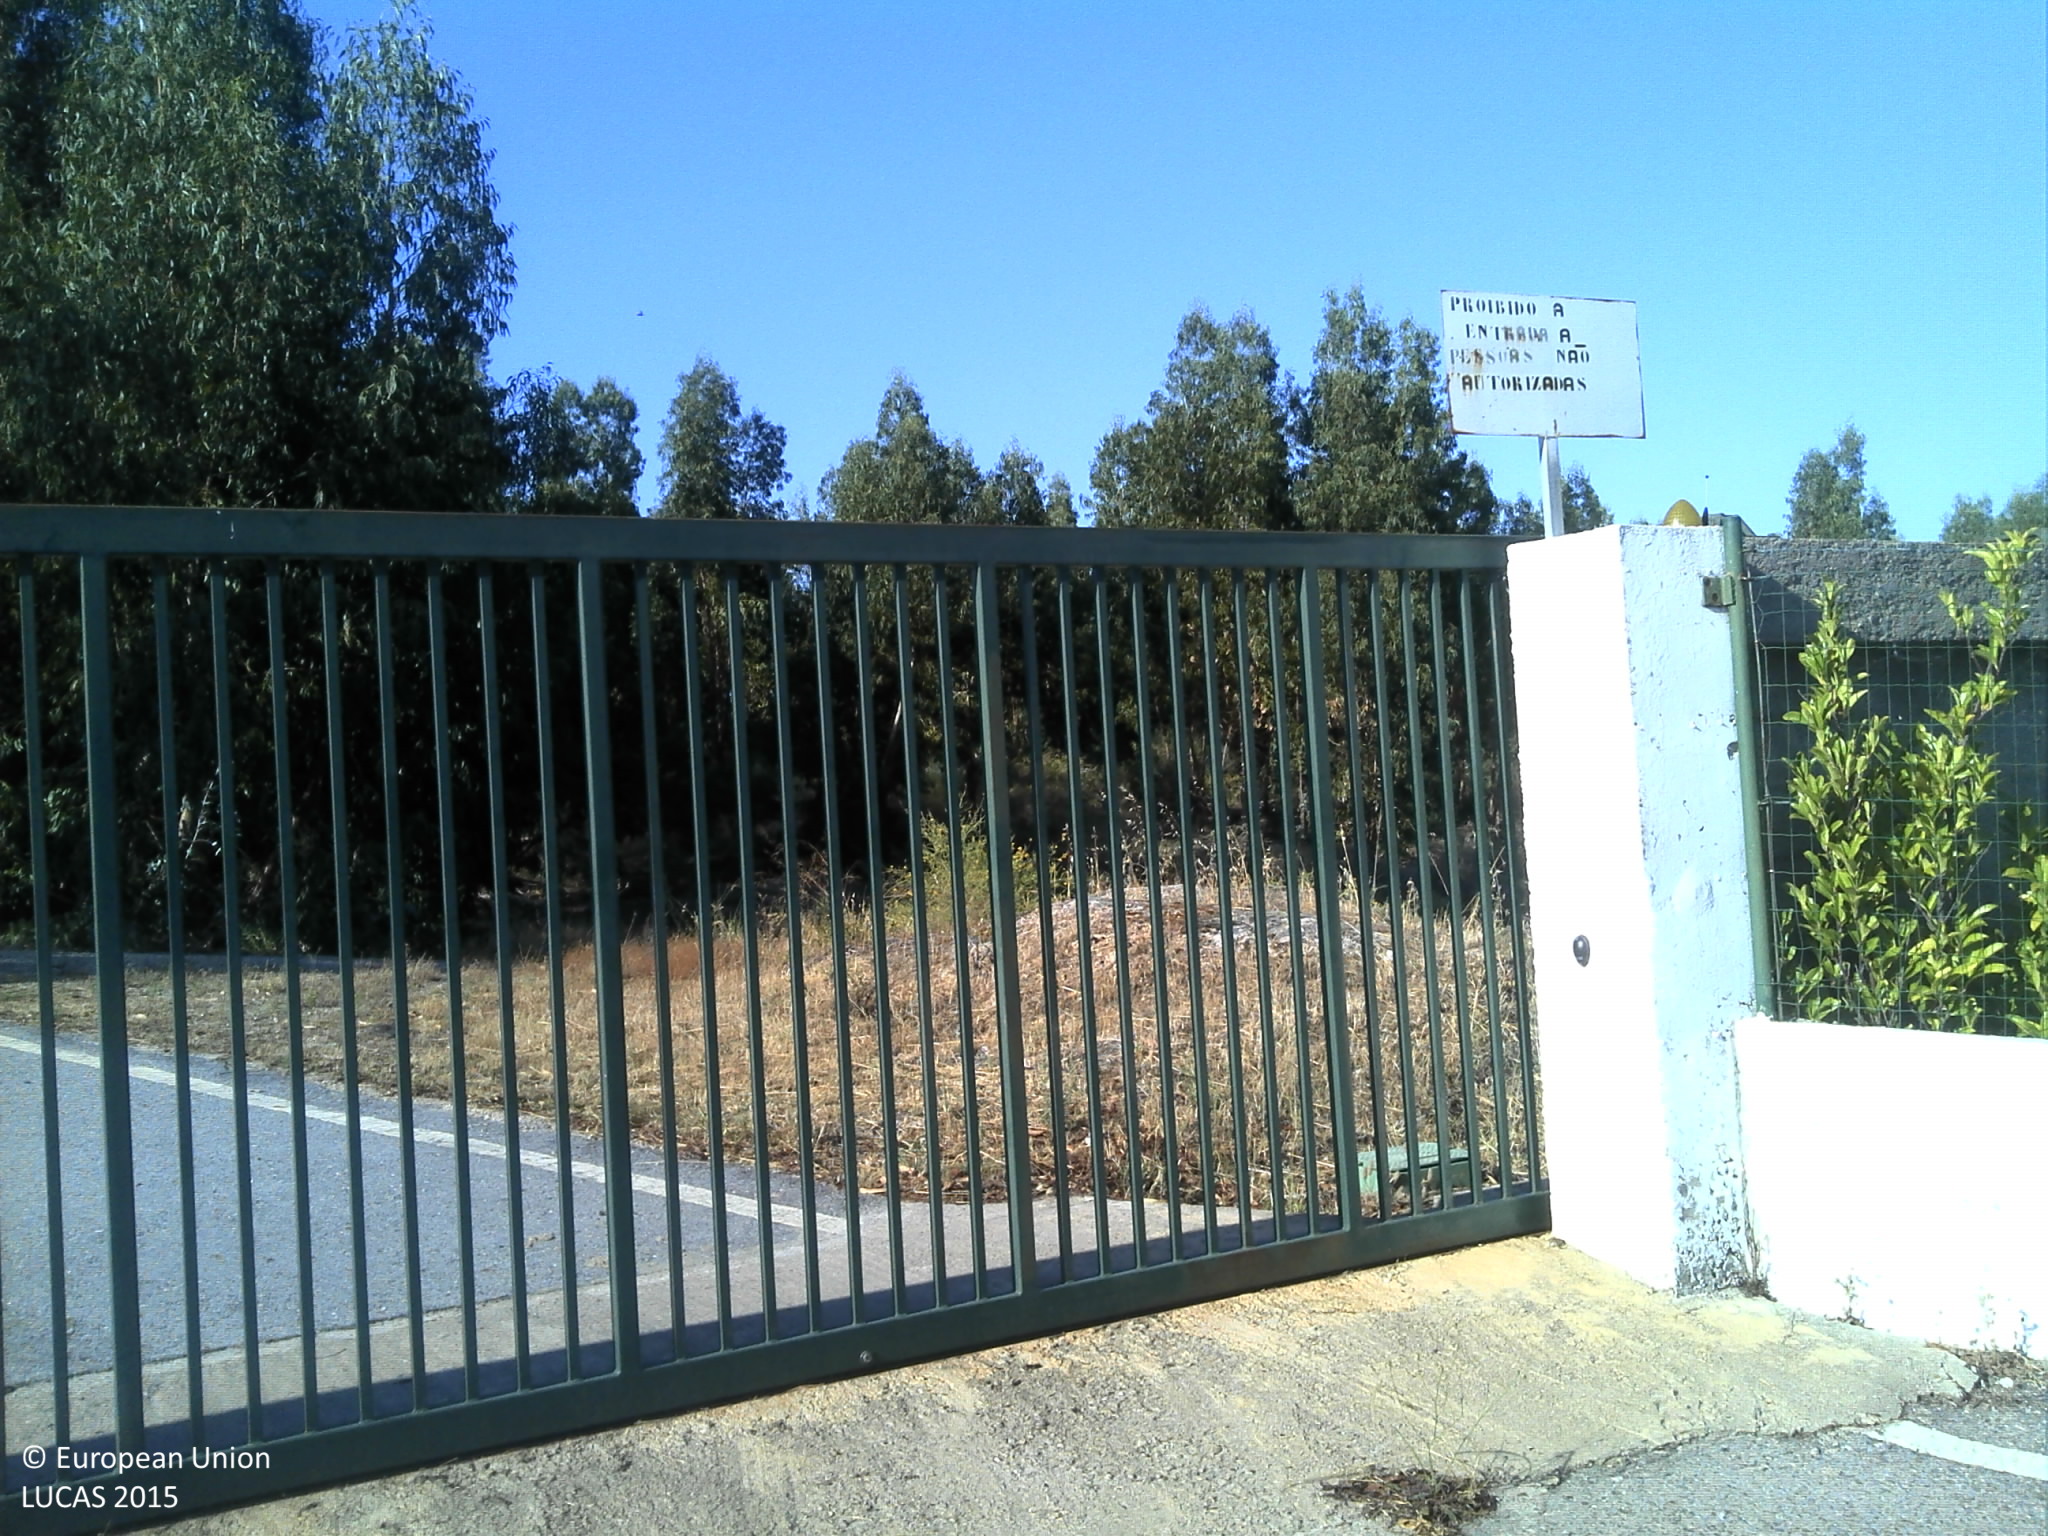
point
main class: Woodland
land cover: Broadleaved woodland
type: broadleaved evergreen forest
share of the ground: 25 - 50 %
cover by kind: broadleaved forest trees 40 %, unconsolidated bare surface 40 %, herbaceous plants 20 %
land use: Forestry
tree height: > 5 m
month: June
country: PT
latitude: 39.9519
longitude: -7.4111
